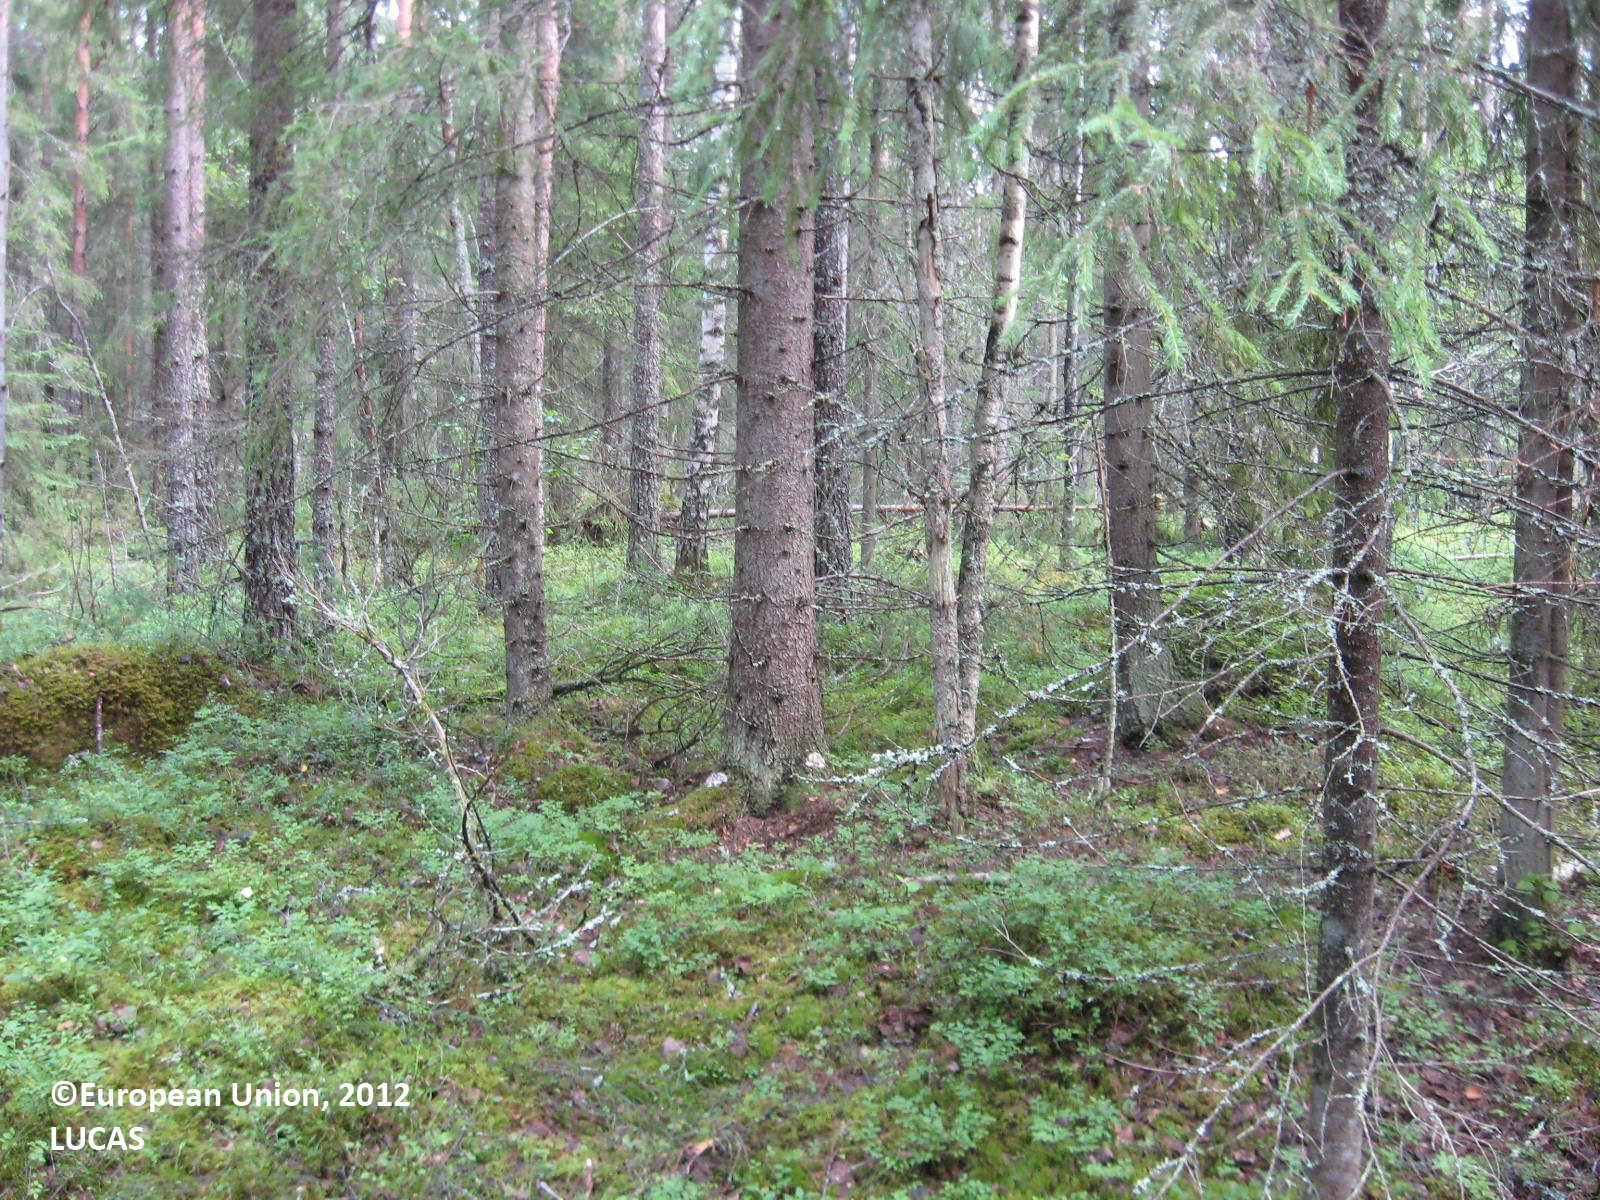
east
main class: Woodland
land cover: Other mixed woodland
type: boreal forest
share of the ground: > 75 %
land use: Forestry
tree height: > 5 m
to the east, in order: Other mixed woodland; Other coniferous woodland; Other mixed woodland; Pine dominated coniferous woodland
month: July
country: FI
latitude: 62.0291
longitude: 22.7729
